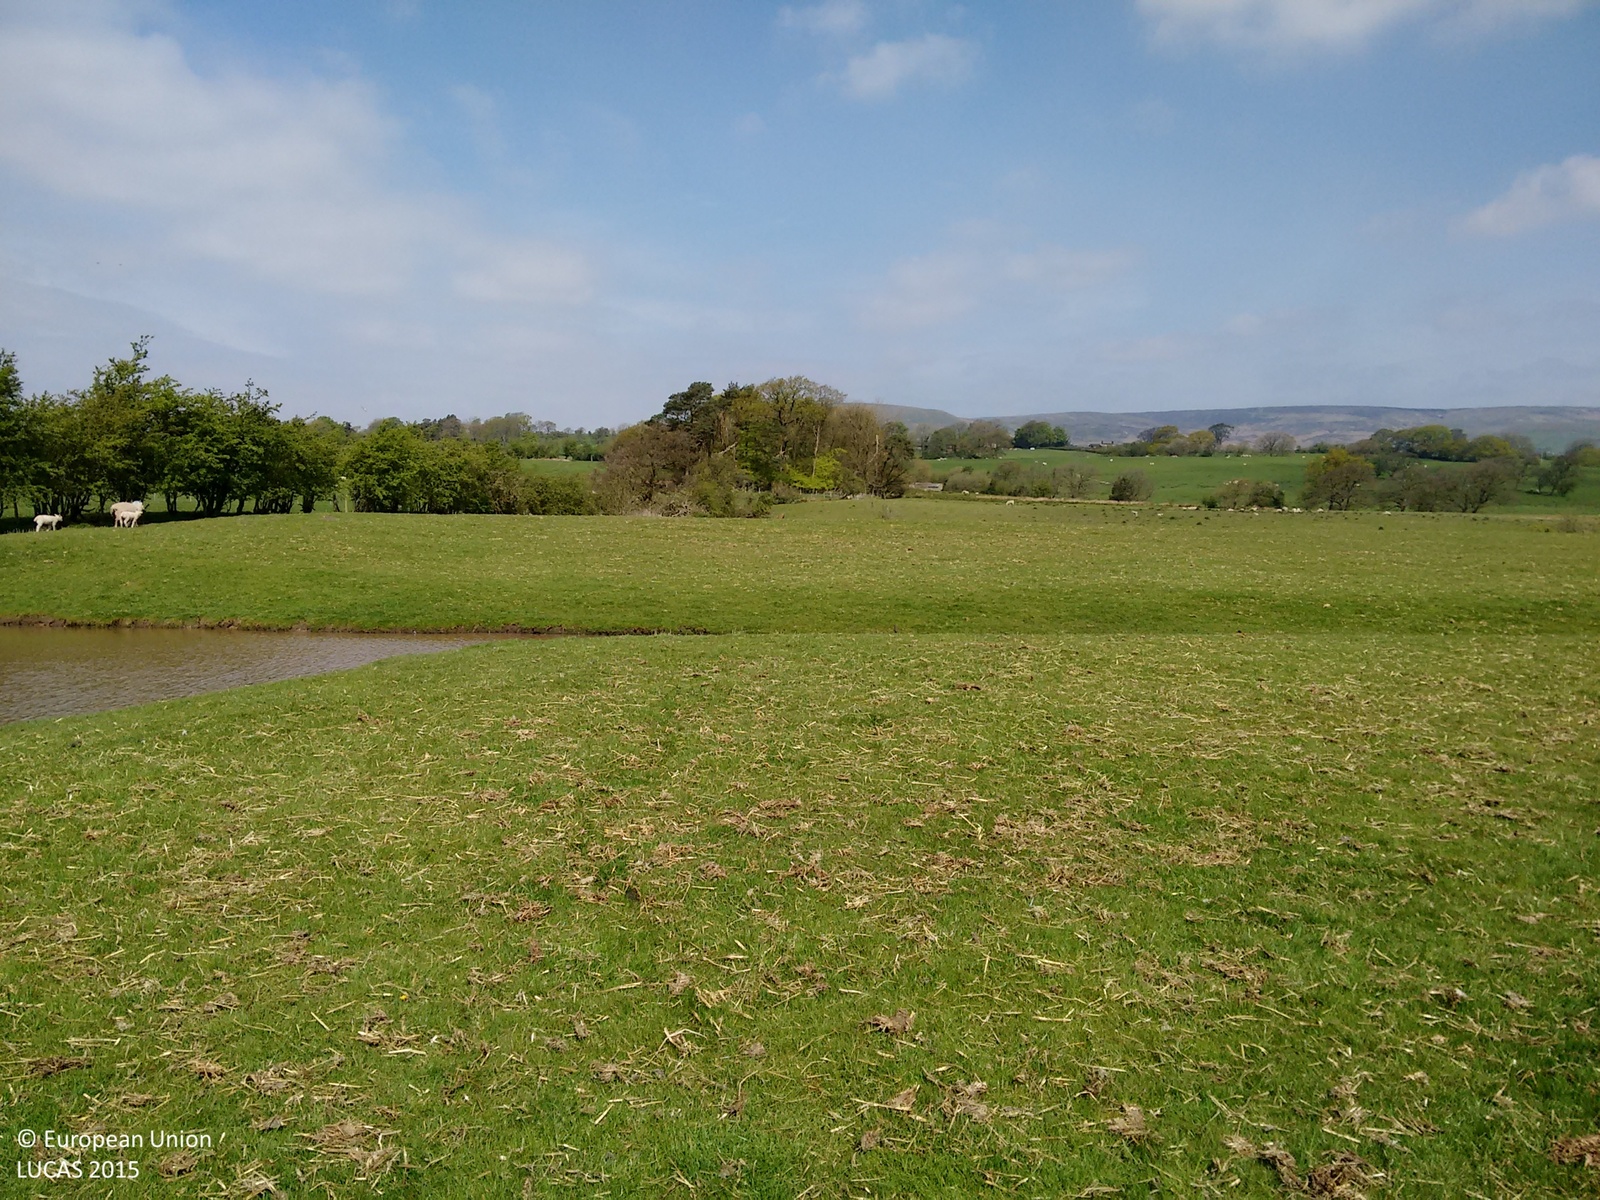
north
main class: Grassland
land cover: Grassland without tree/shrub cover
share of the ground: > 75 %
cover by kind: herbaceous plants 100 %
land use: Agriculture (excluding fallow land and kitchen gardens)
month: May
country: GB
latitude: 53.8712
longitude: -2.5831
